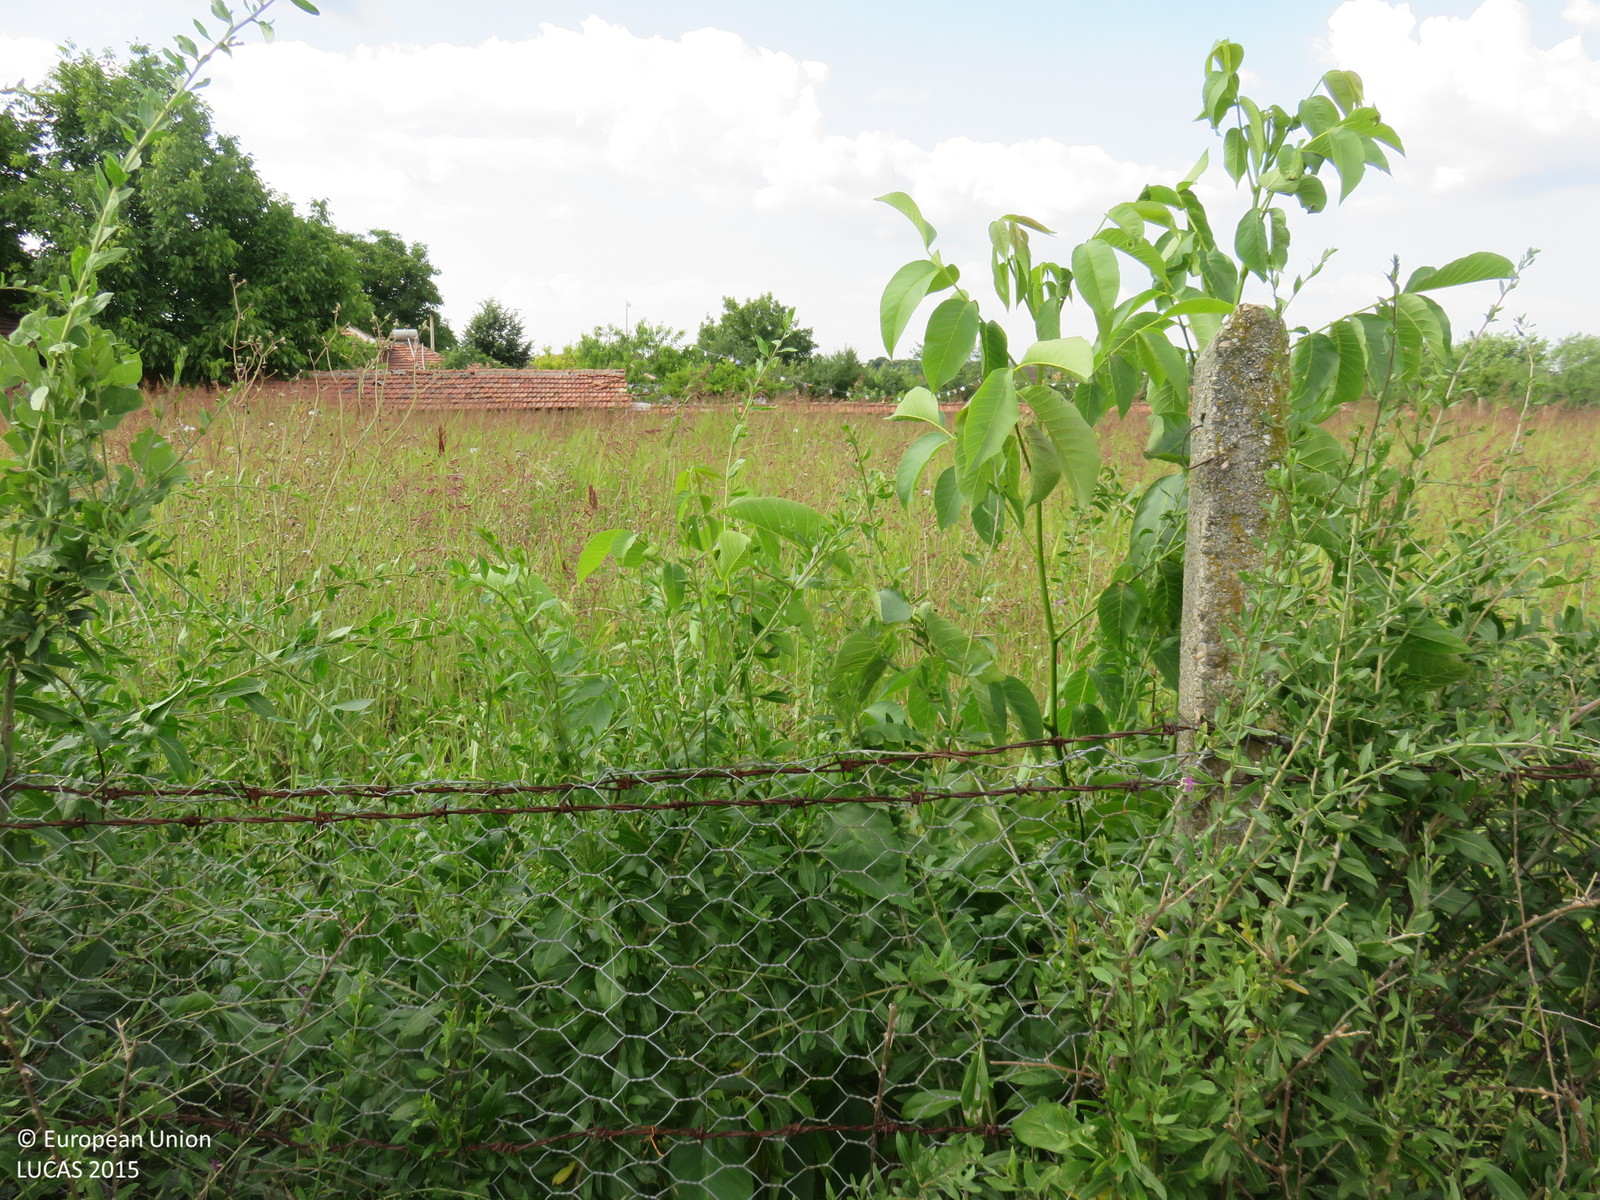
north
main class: Grassland
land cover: Grassland without tree/shrub cover
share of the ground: > 75 %
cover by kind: herbaceous plants 100 %
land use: Residential
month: June
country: BG
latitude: 43.3364
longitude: 24.9309
